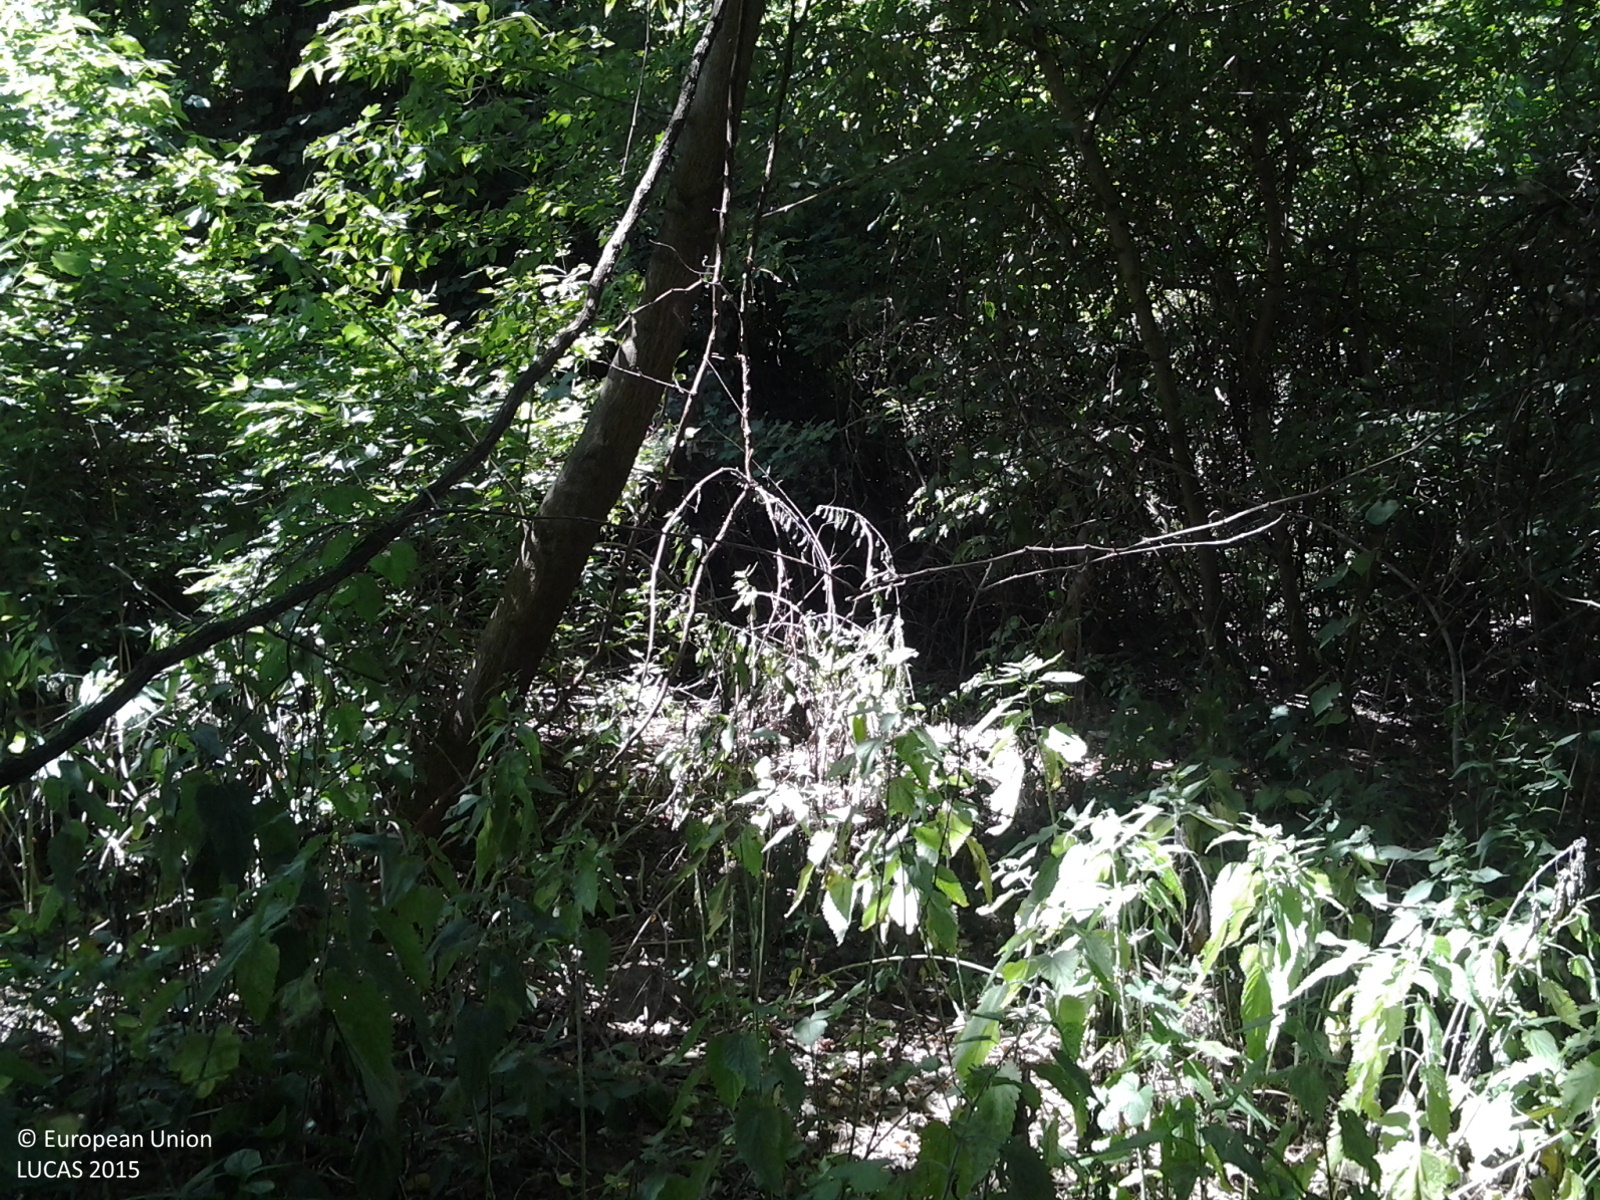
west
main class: Woodland
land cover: Broadleaved woodland
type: floodplain forest
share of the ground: > 75 %
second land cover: Spontaneously vegetated surfaces
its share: > 75 %
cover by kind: broadleaved forest trees 50 %, shrubs 40 %, herbaceous plants 10 %
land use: Forestry
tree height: > 5 m
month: July
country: HU
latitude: 47.4210
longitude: 20.4087
